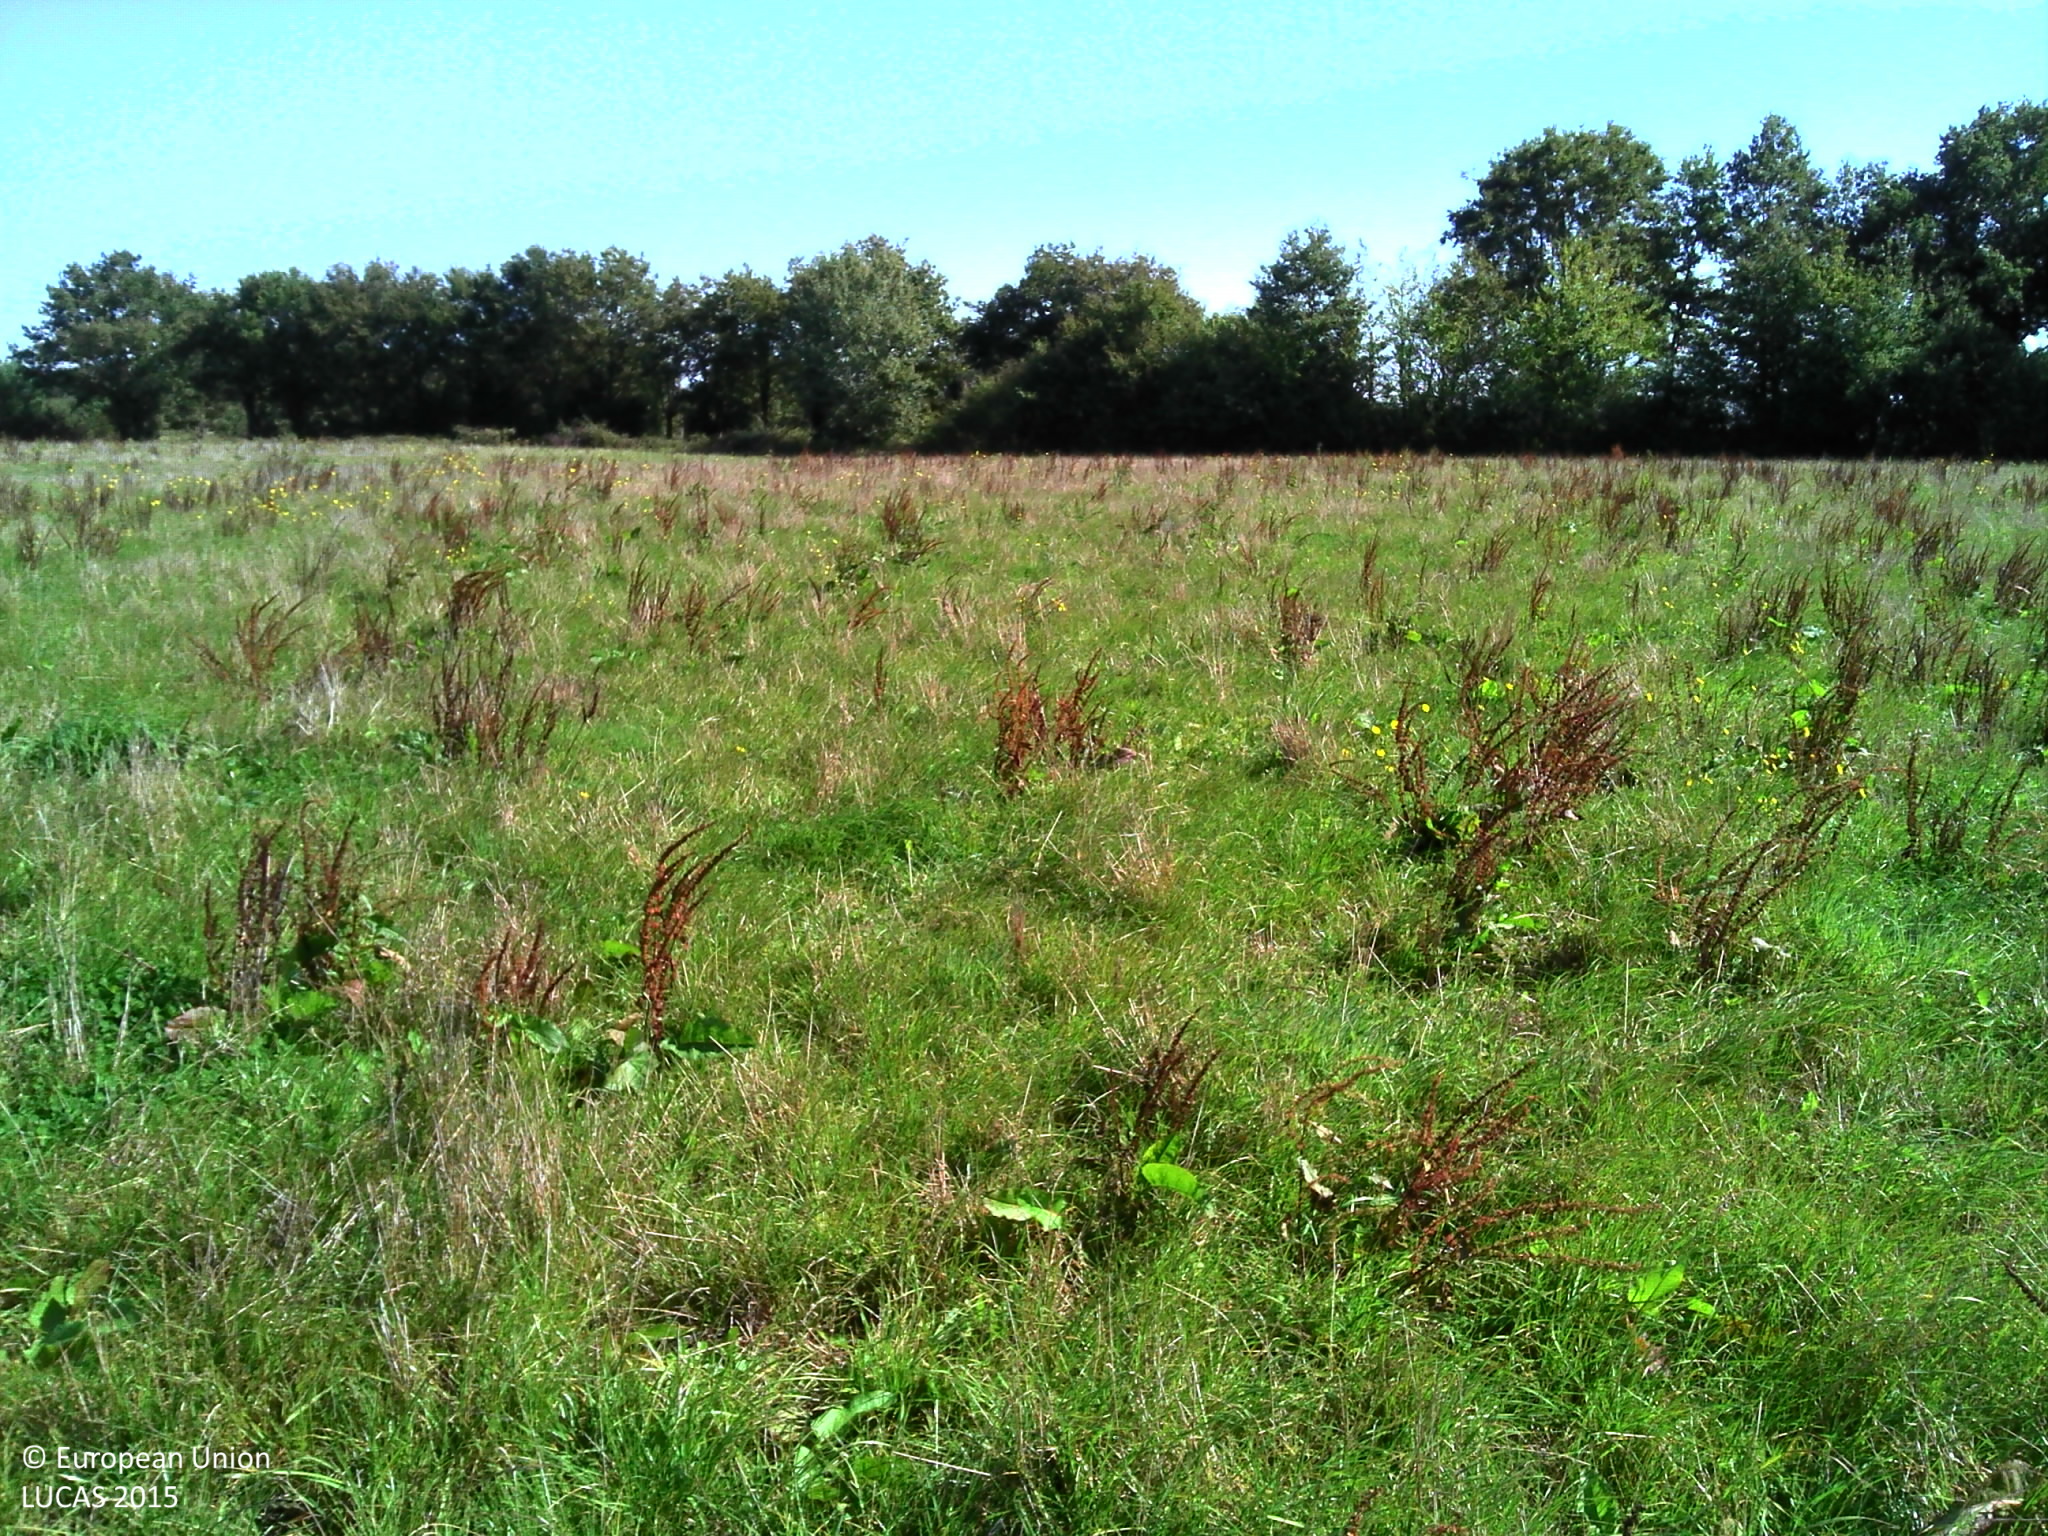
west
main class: Grassland
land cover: Grassland without tree/shrub cover
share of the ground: > 75 %
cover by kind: herbaceous plants 100 %
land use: Agriculture (excluding fallow land and kitchen gardens)
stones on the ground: < 10 %
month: September
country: FR
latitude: 46.6044
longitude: -1.3026
